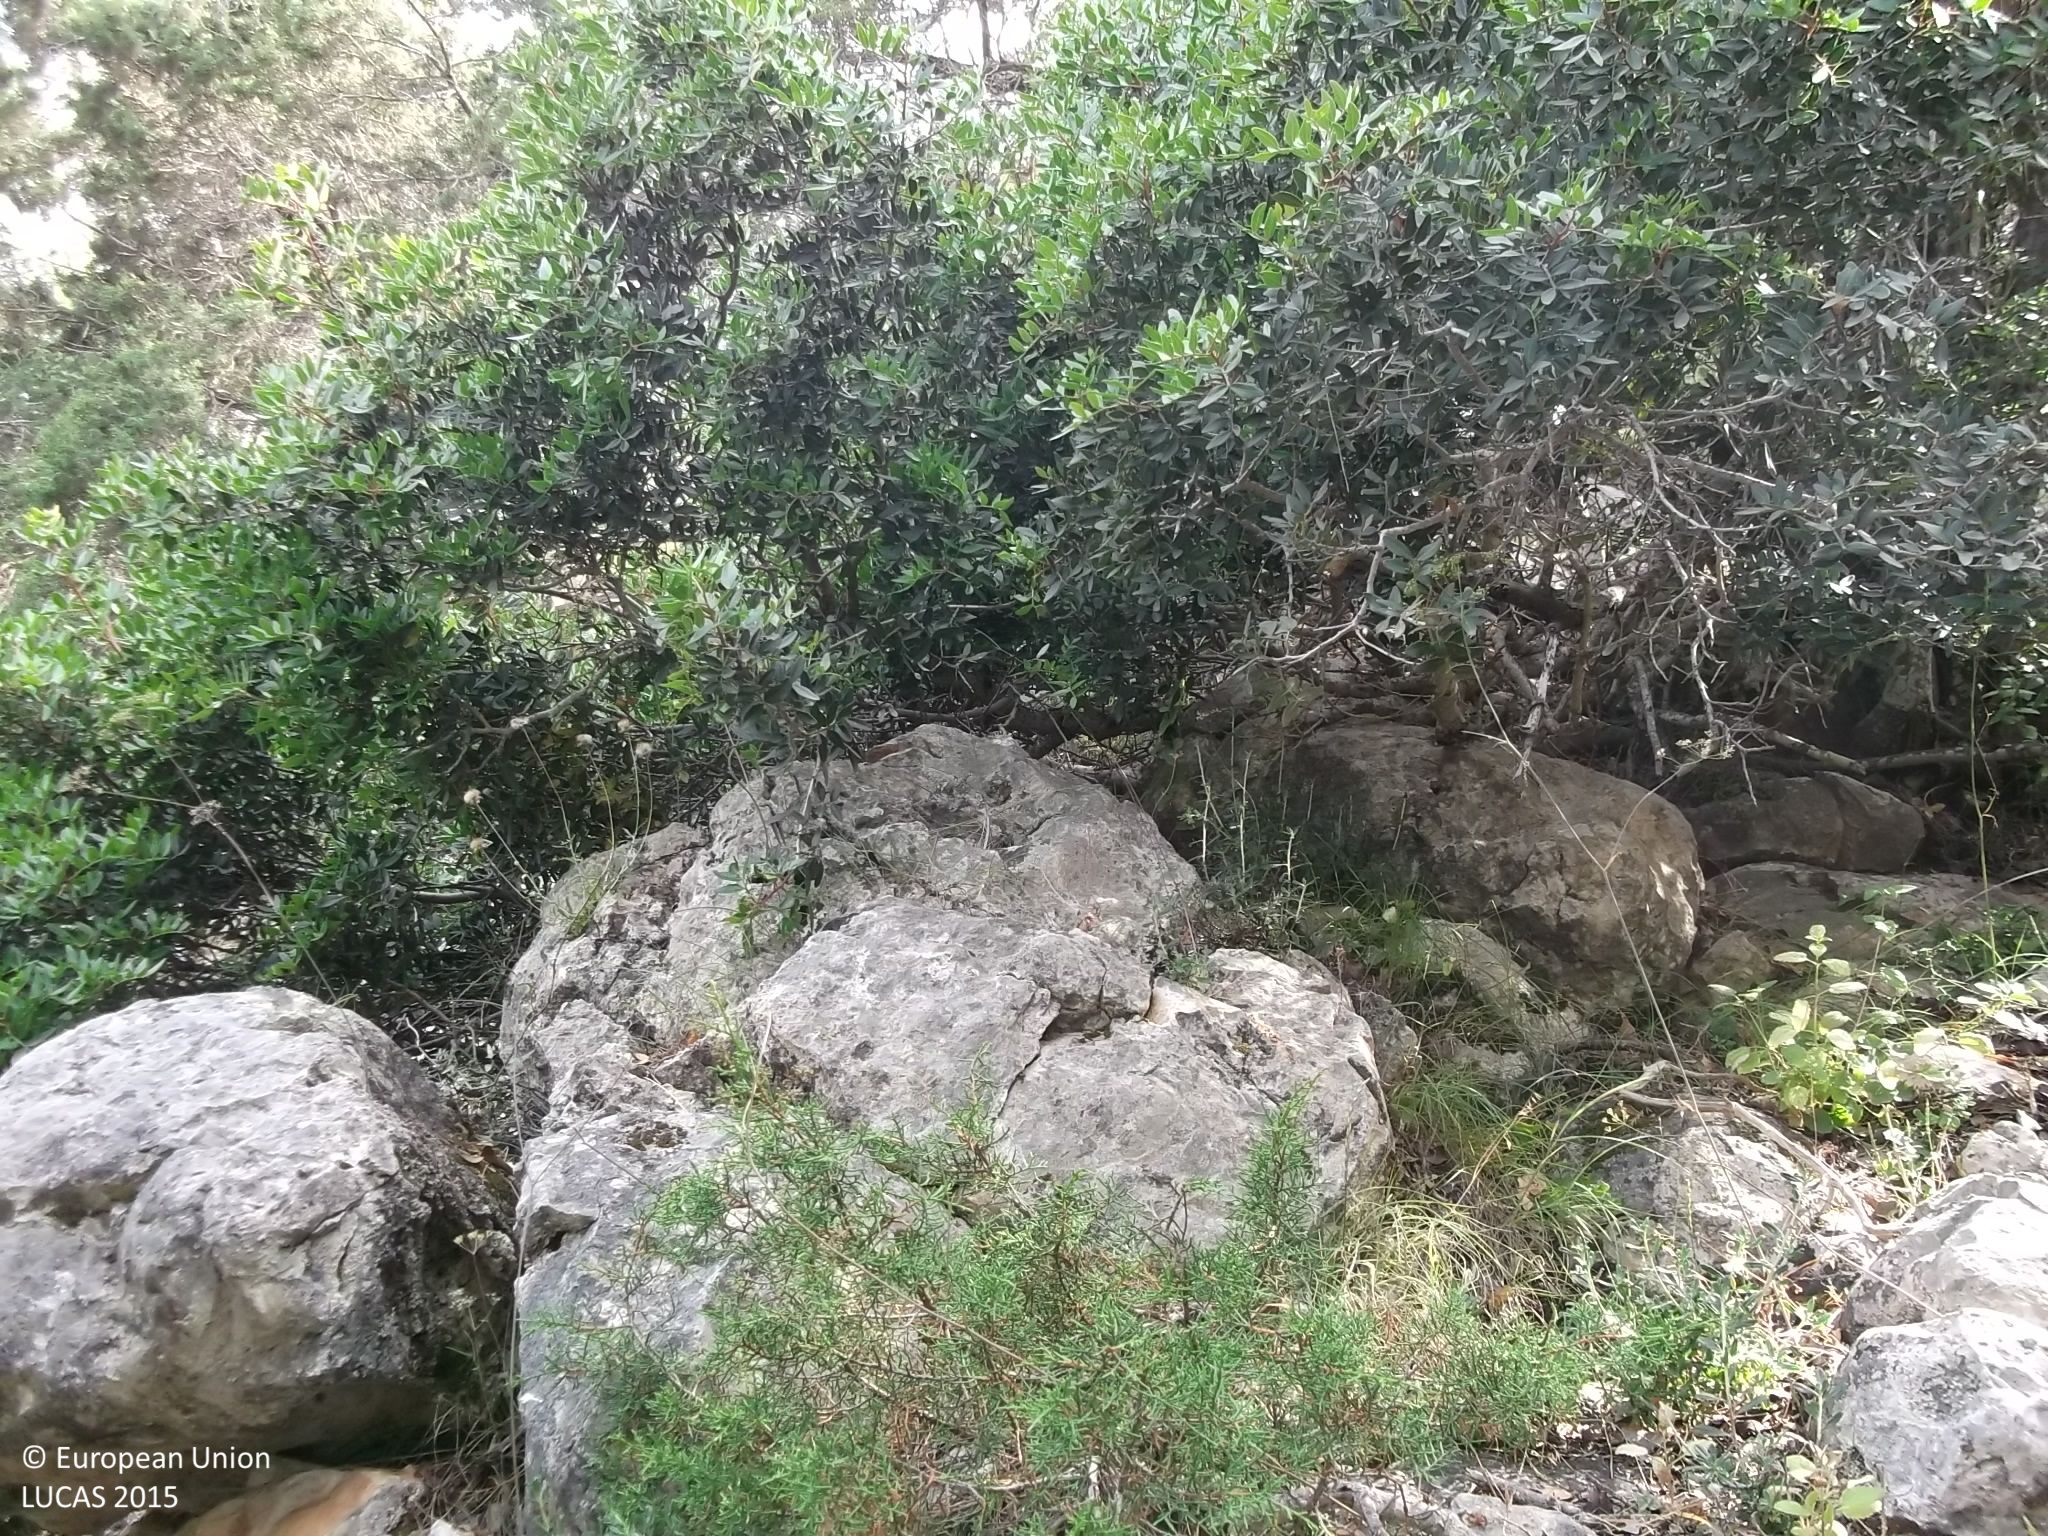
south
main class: Woodland
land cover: Pine dominated coniferous woodland
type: coniferous forest of the mediterranean region
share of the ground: 50 - 75 %
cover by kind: coniferous forest trees 75 %, unconsolidated bare surface 25 %
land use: Semi-natural and natural areas not in use
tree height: < 5 m
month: May
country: CY
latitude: 35.0559
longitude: 32.3311
